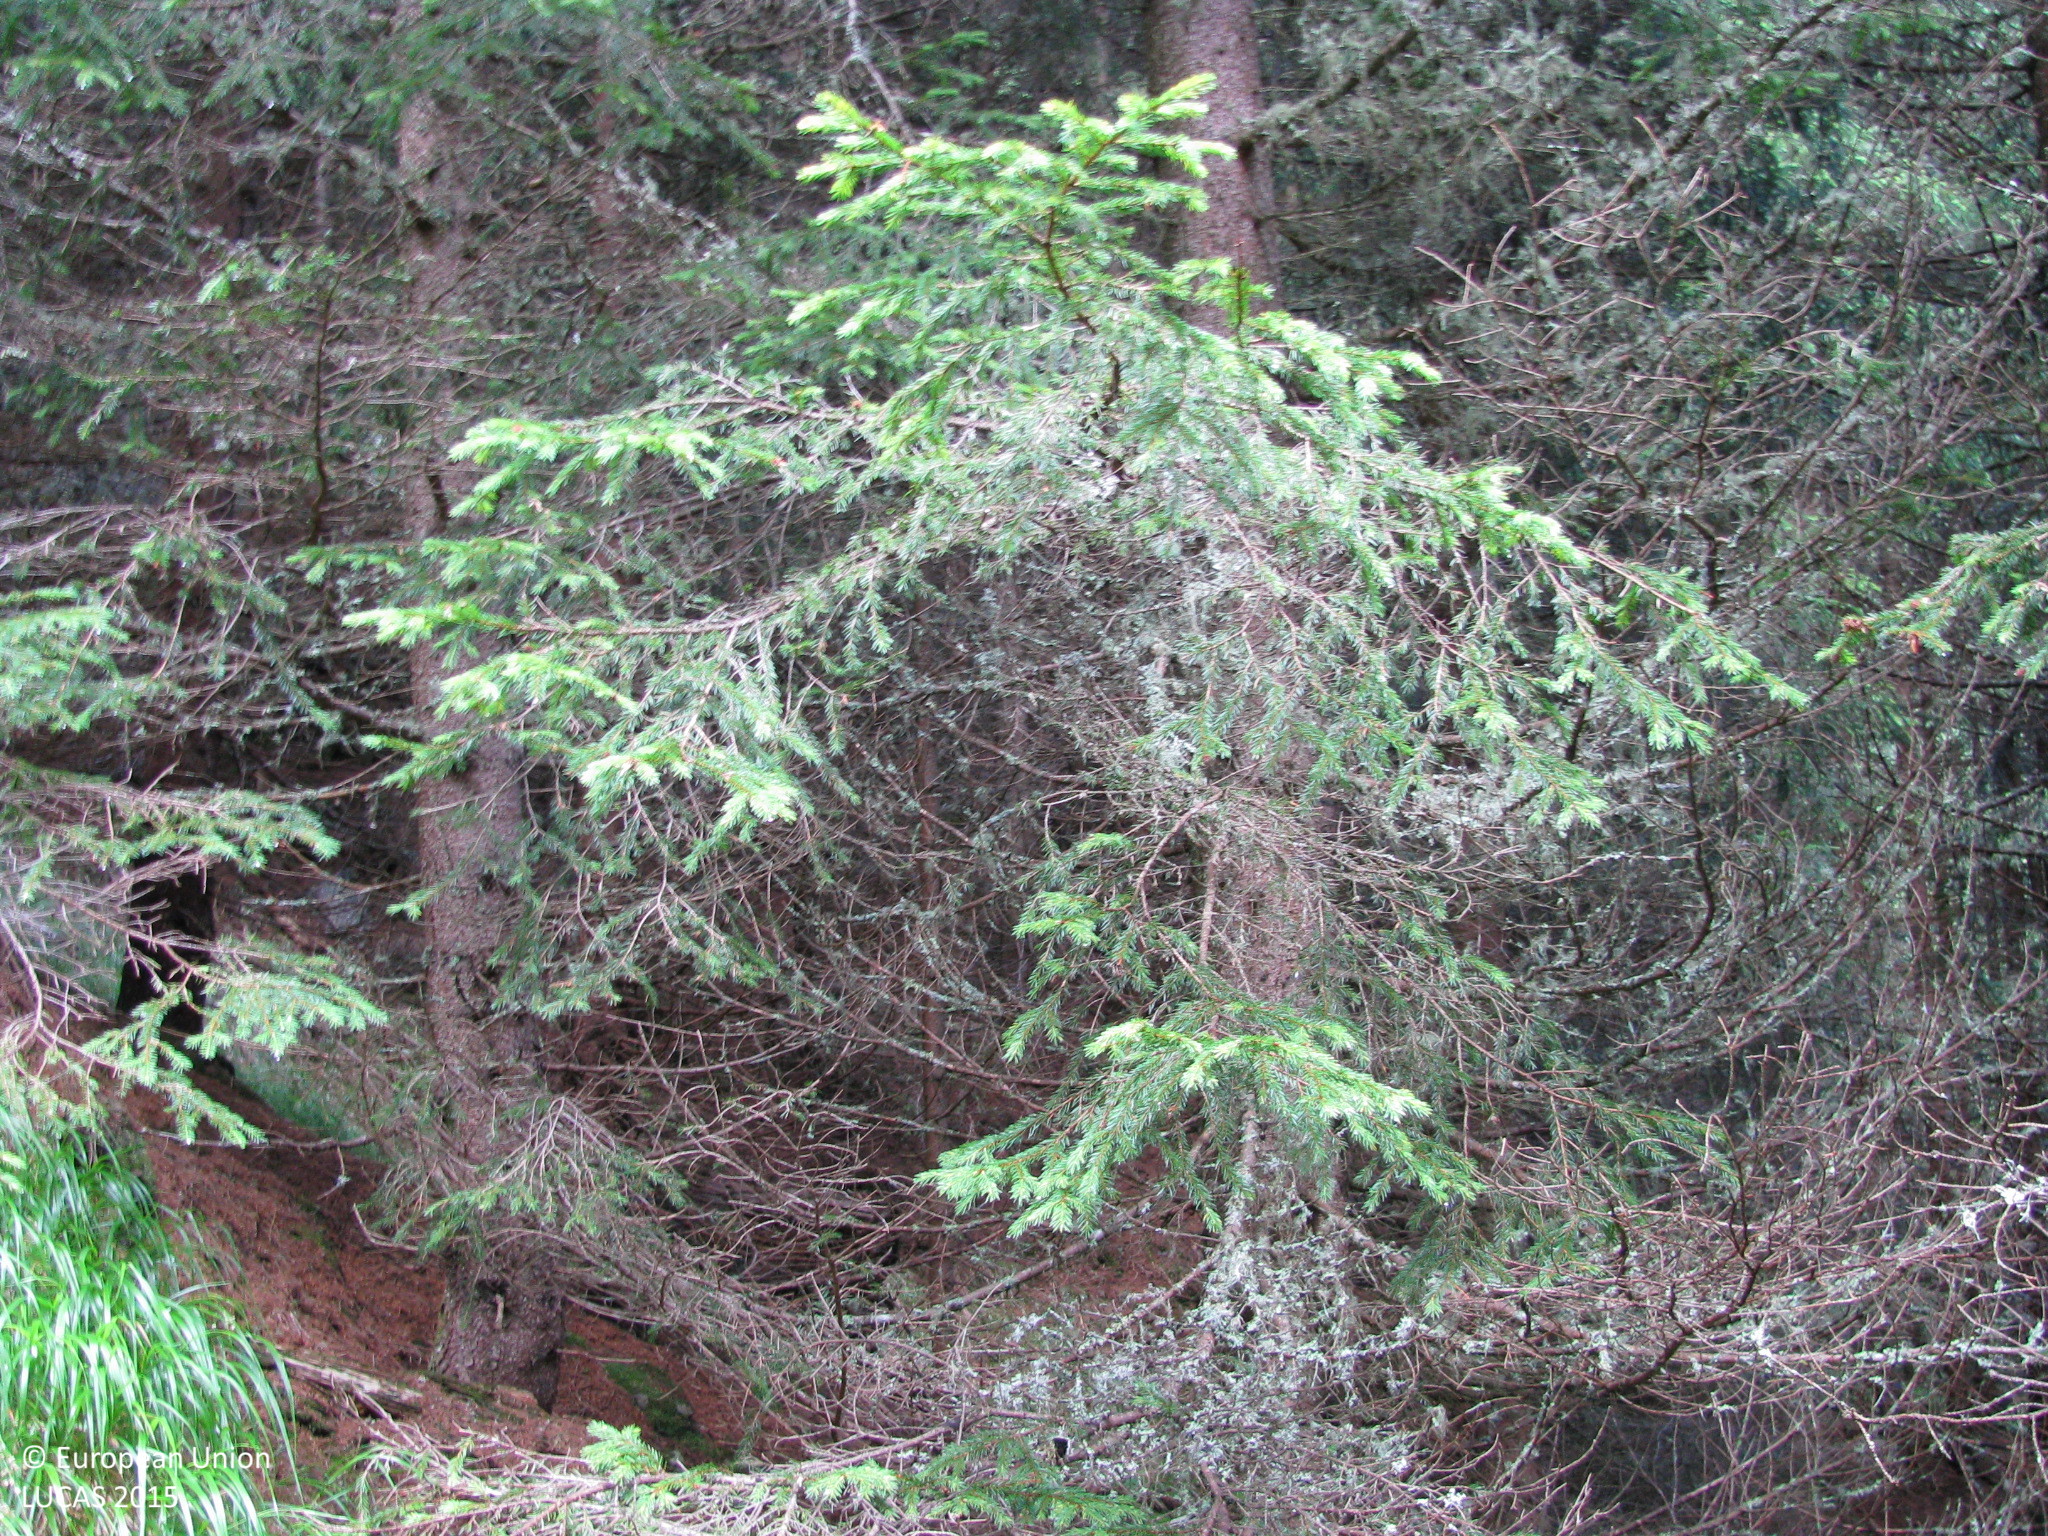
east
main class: Woodland
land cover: Spruce dominated coniferous woodland
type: alpine coniferous forest
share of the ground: > 75 %
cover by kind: coniferous forest trees 90 %, herbaceous plants 10 %
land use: Forestry
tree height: > 5 m
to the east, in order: Spruce dominated coniferous woodland; Broadleaved woodland; Rivers and streams; Broadleaved woodland; Tracks; Broadleaved woodland; Spruce dominated coniferous woodland
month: July
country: AT
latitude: 46.8234
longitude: 12.6323
